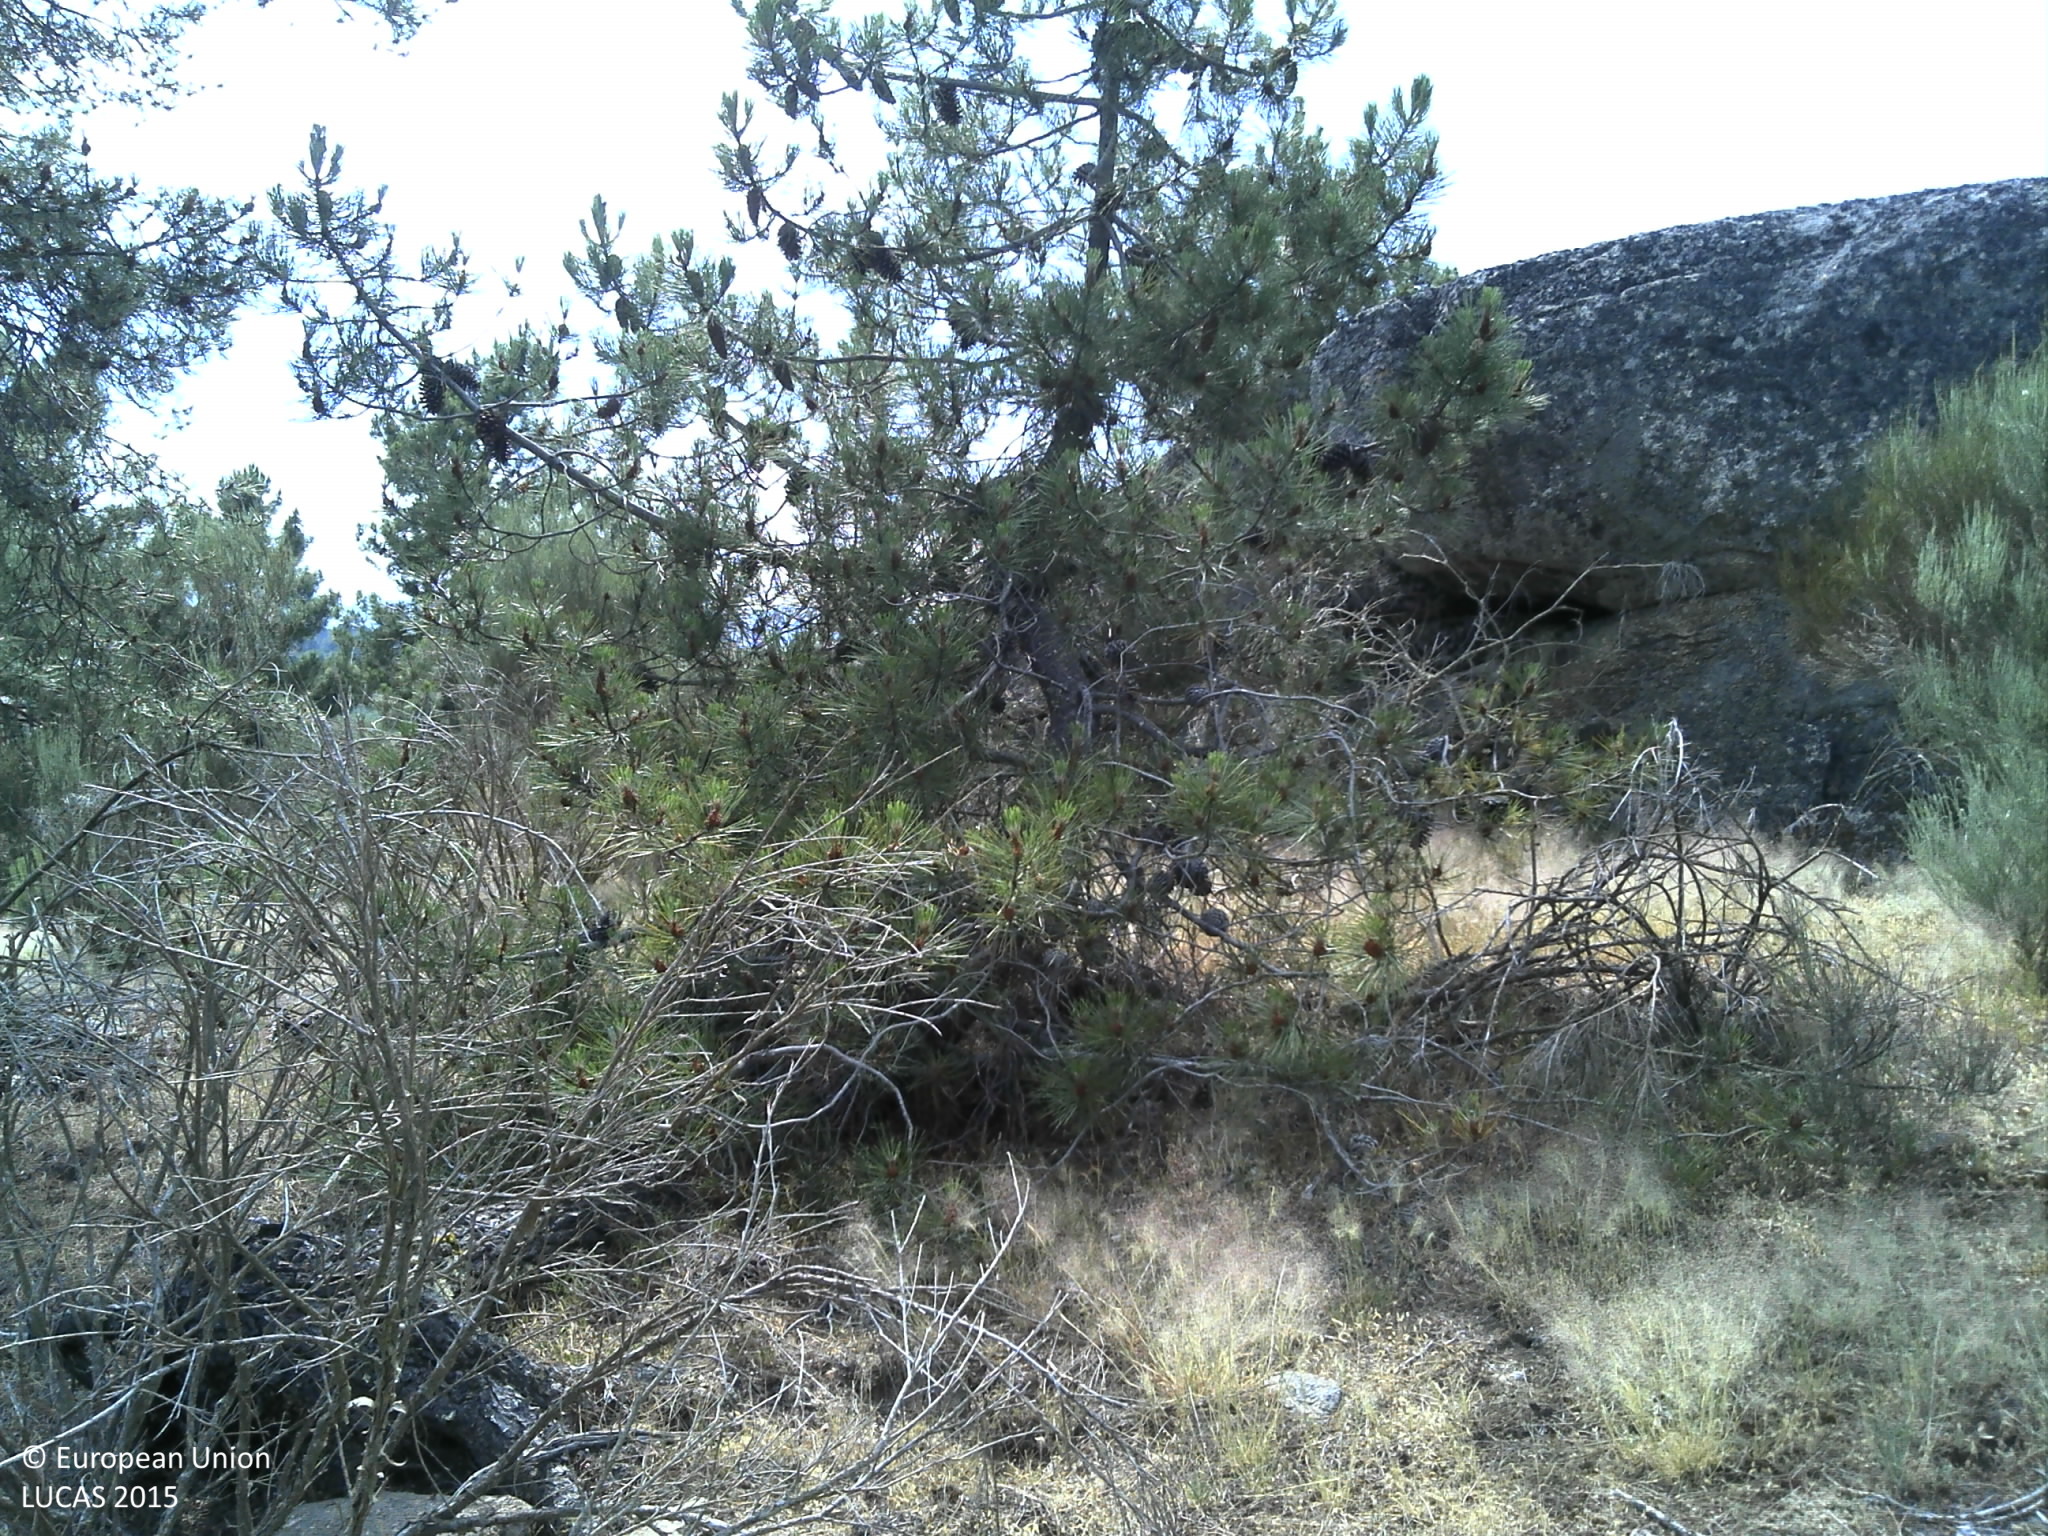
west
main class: Shrubland
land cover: Shrubland with sparse tree cover
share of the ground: > 75 %
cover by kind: shrubs 55 %, herbaceous plants 30 %, consolidated bare surface 10 %, coniferous forest trees 5 %
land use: Semi-natural and natural areas not in use
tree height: > 5 m
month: June
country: PT
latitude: 41.3106
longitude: -7.6512
